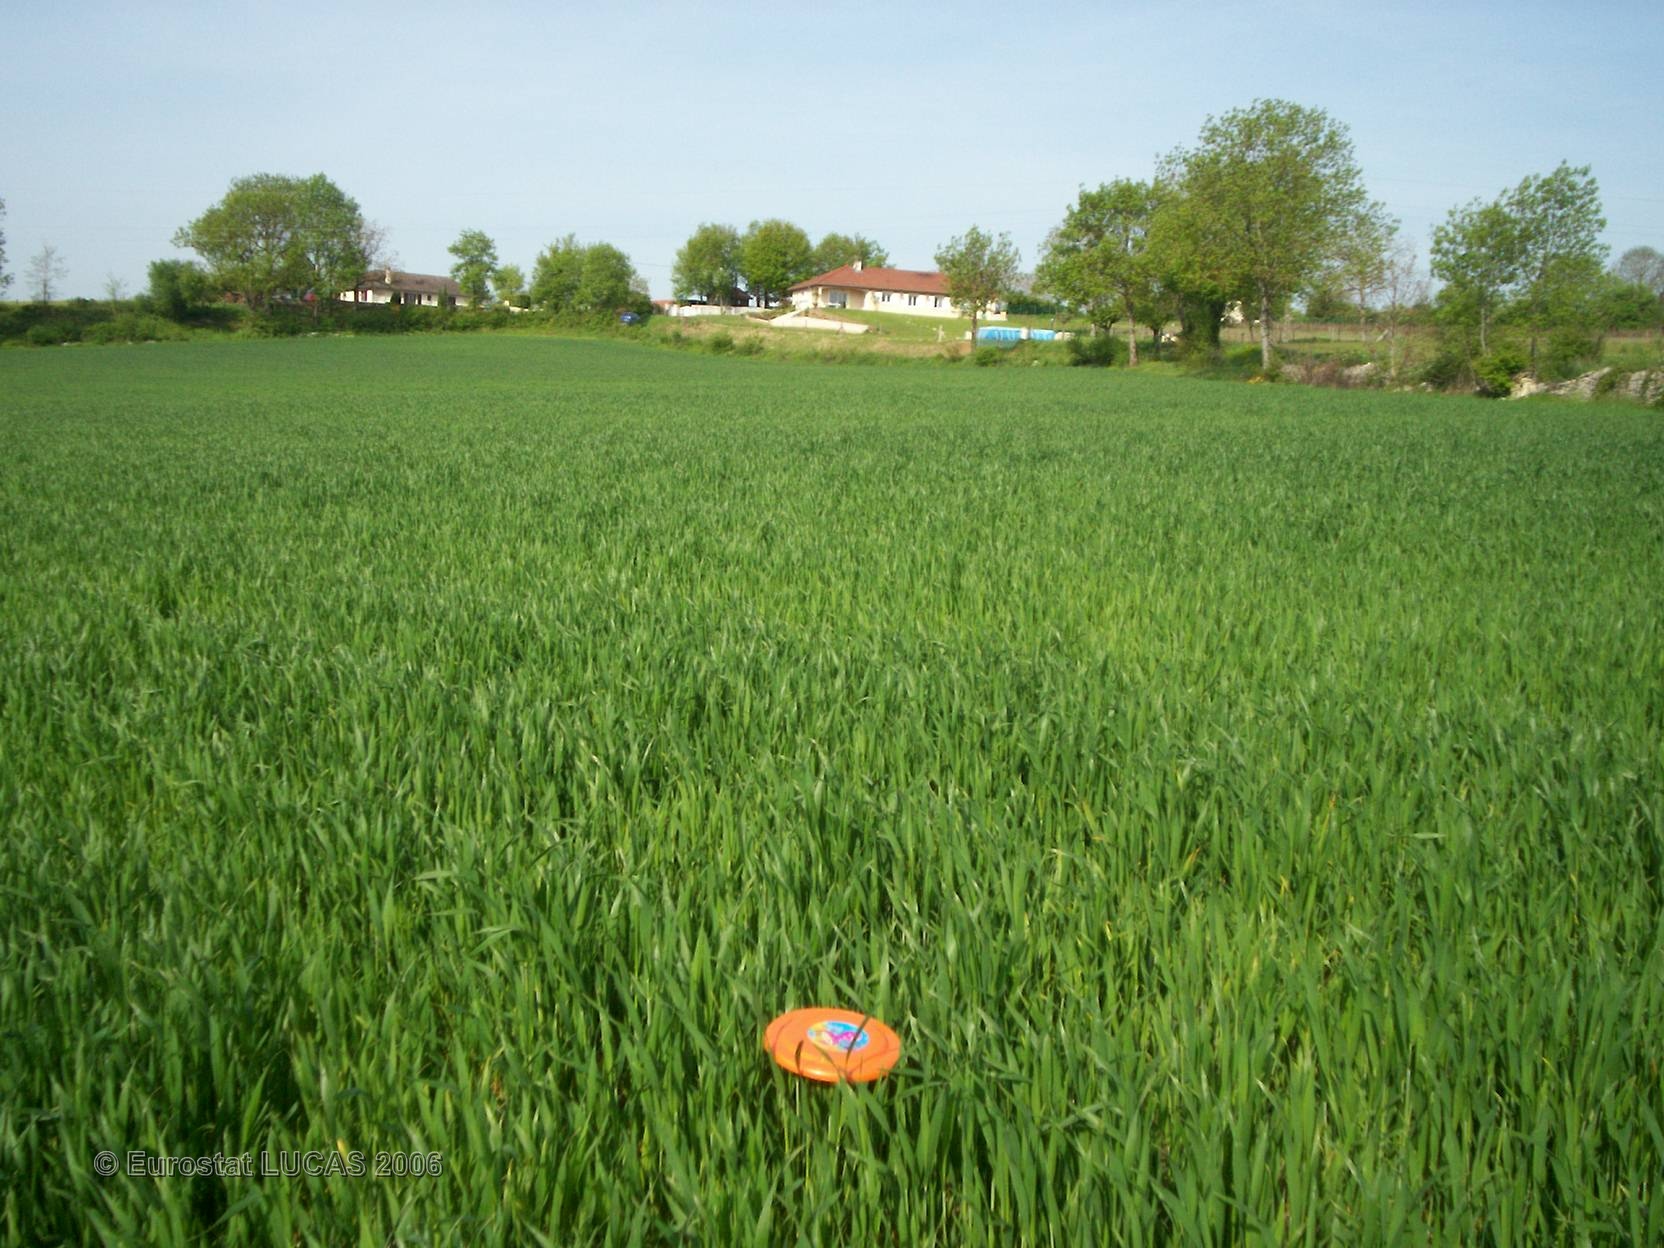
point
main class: Cropland
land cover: Common wheat
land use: Agriculture (excluding fallow land and kitchen gardens)
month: May
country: FR
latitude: 45.7837
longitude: 5.4121
